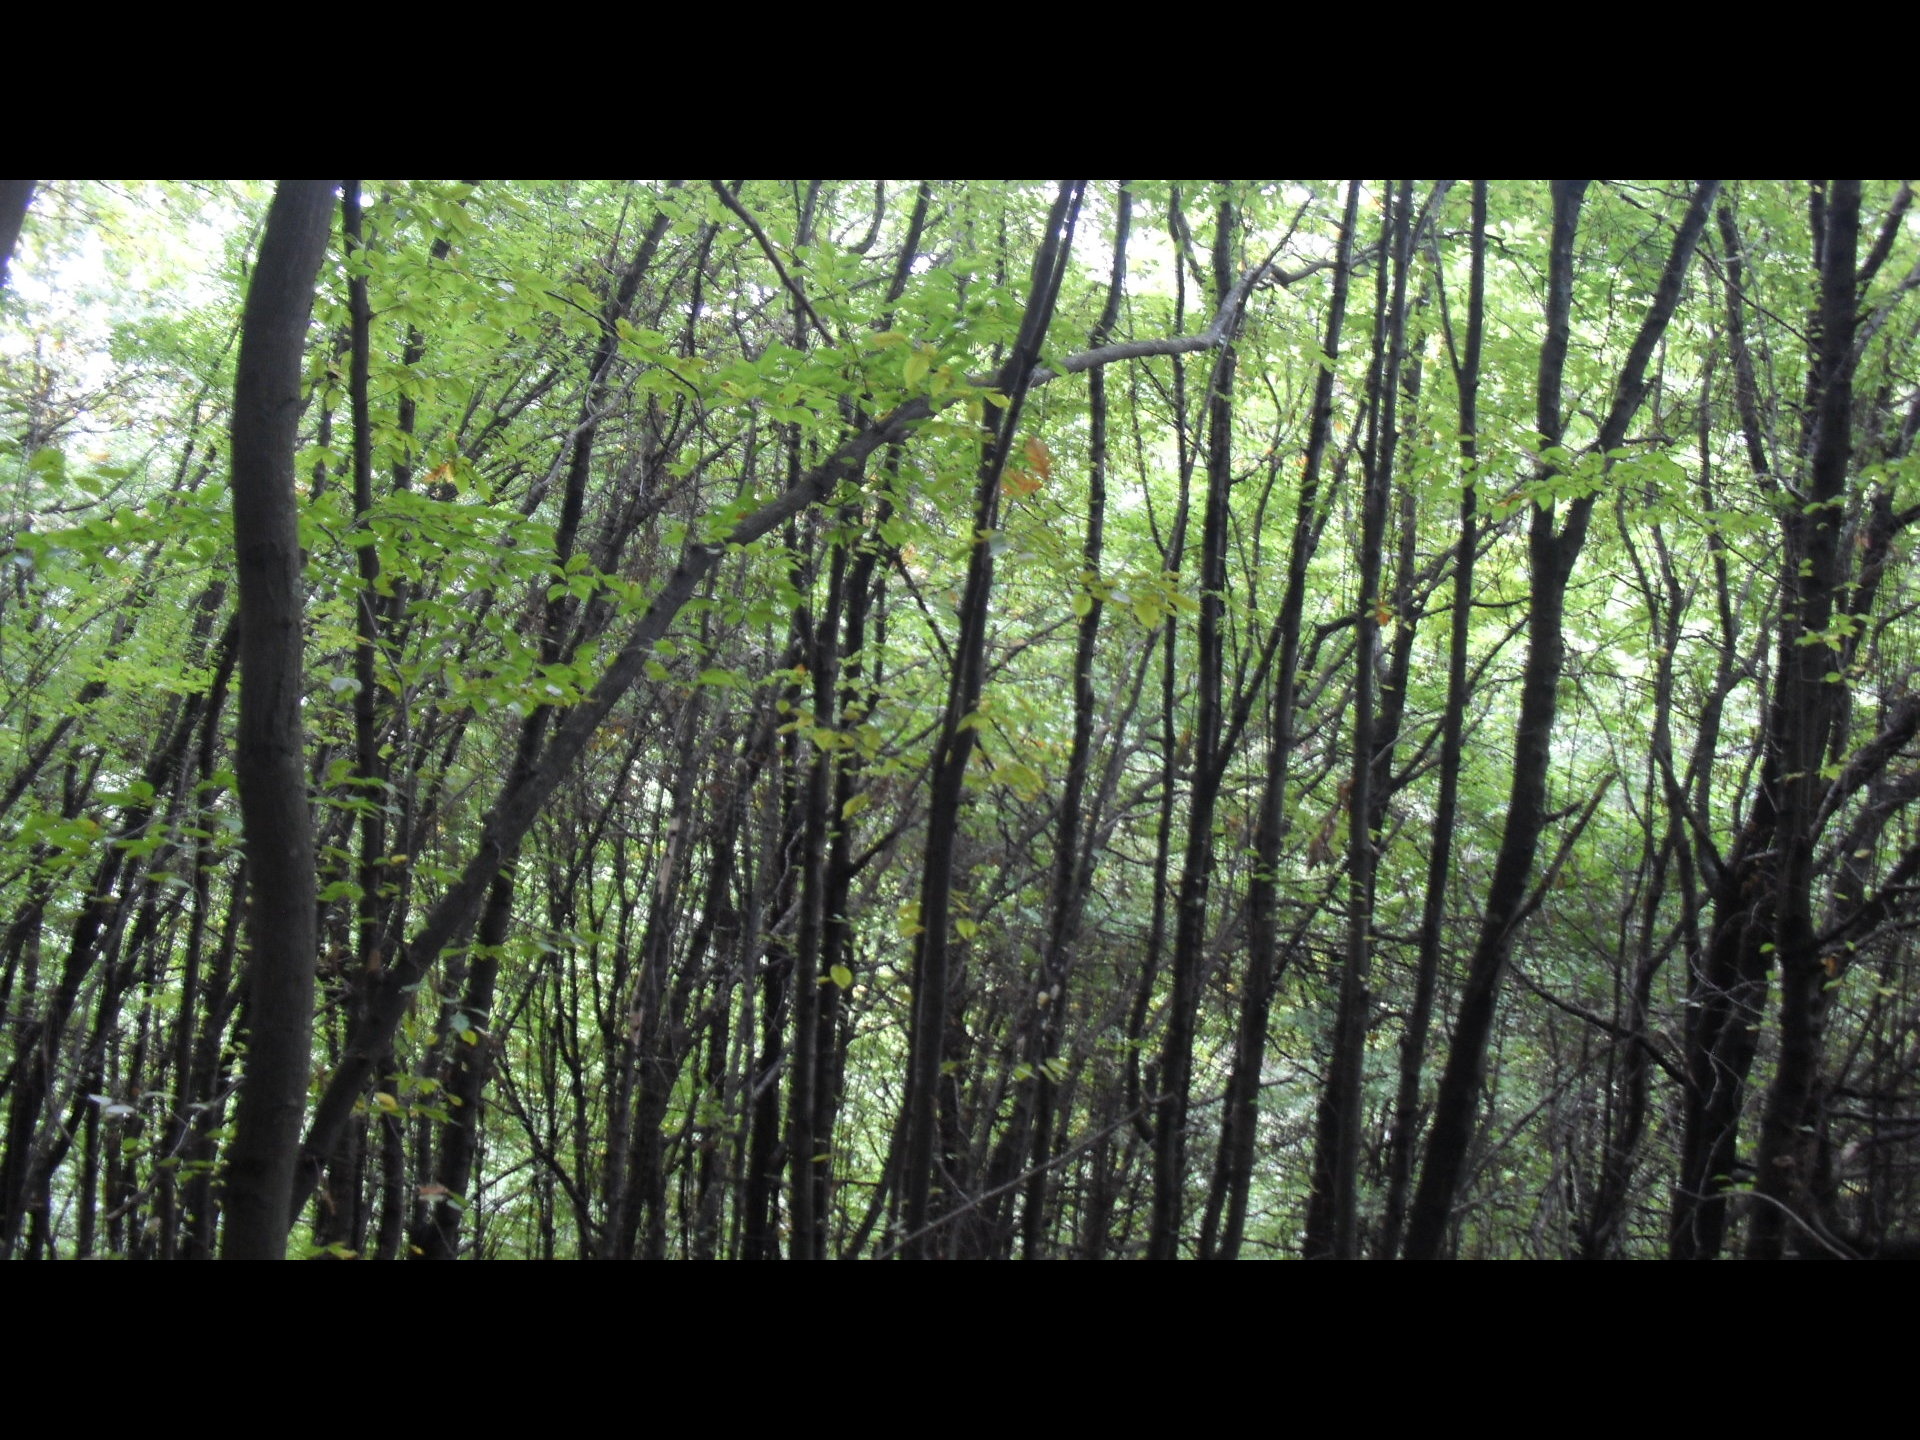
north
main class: Woodland
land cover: Broadleaved woodland
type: mesophytic deciduous forest
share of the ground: > 75 %
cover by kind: broadleaved forest trees 100 %
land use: Forestry
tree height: > 5 m
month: October
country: BG
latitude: 43.4836
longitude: 22.7814
